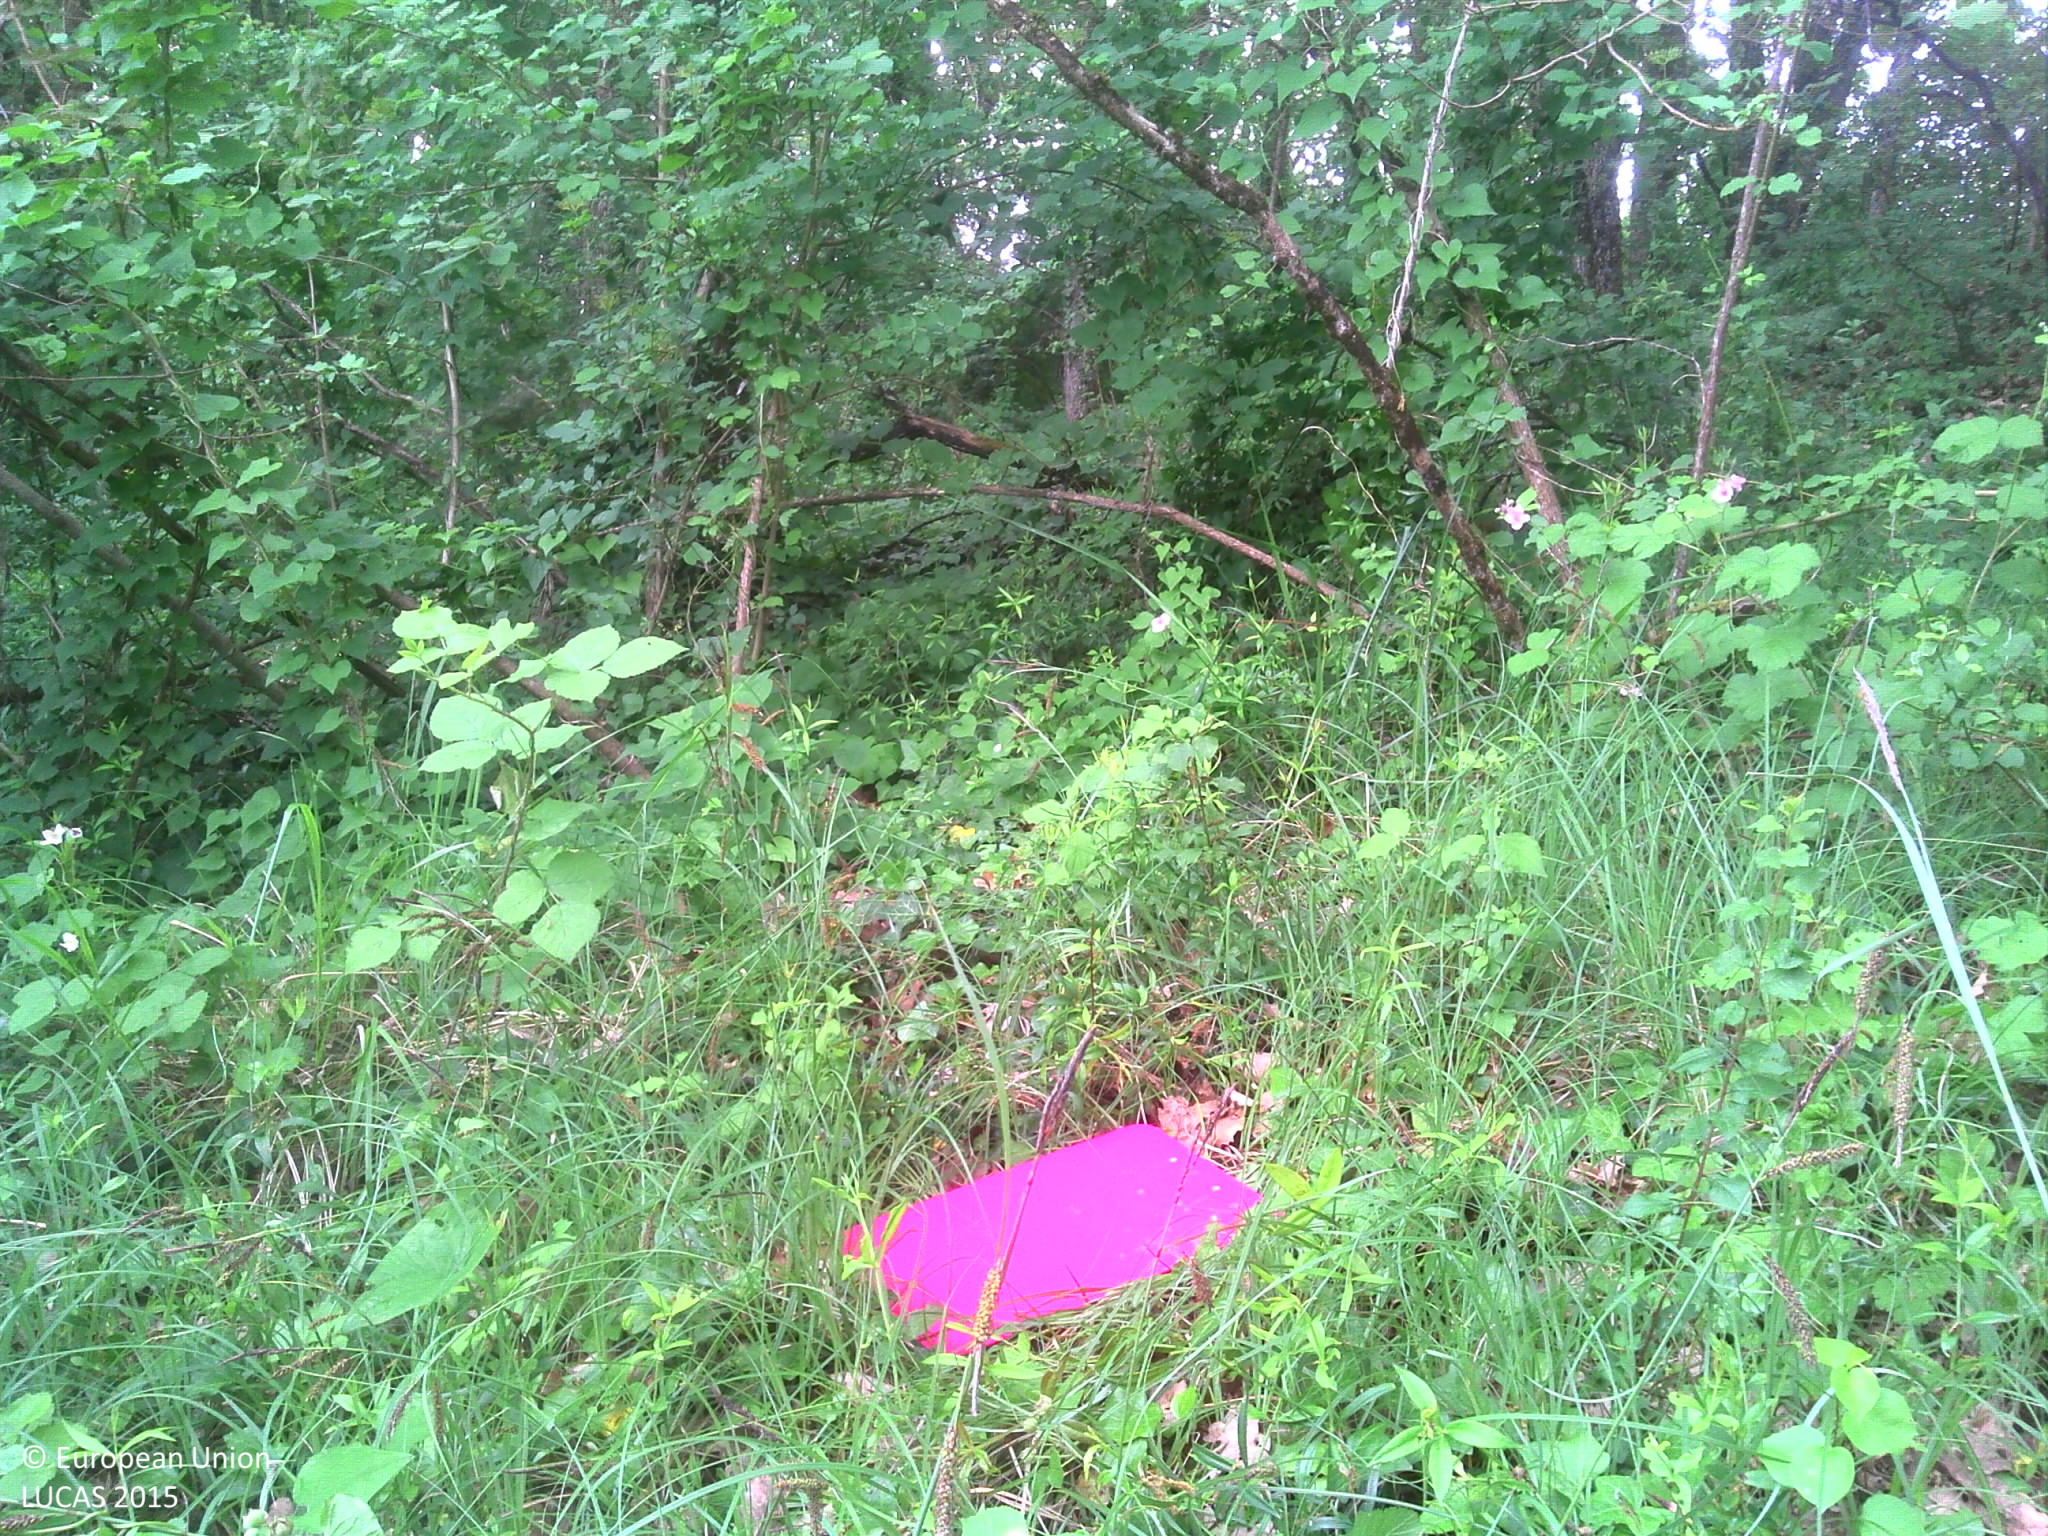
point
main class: Woodland
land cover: Broadleaved woodland
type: mesophytic deciduous forest
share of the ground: > 75 %
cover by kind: broadleaved forest trees 100 %
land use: Forestry
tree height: > 5 m
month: June
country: FR
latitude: 43.7246
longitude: 2.1221
